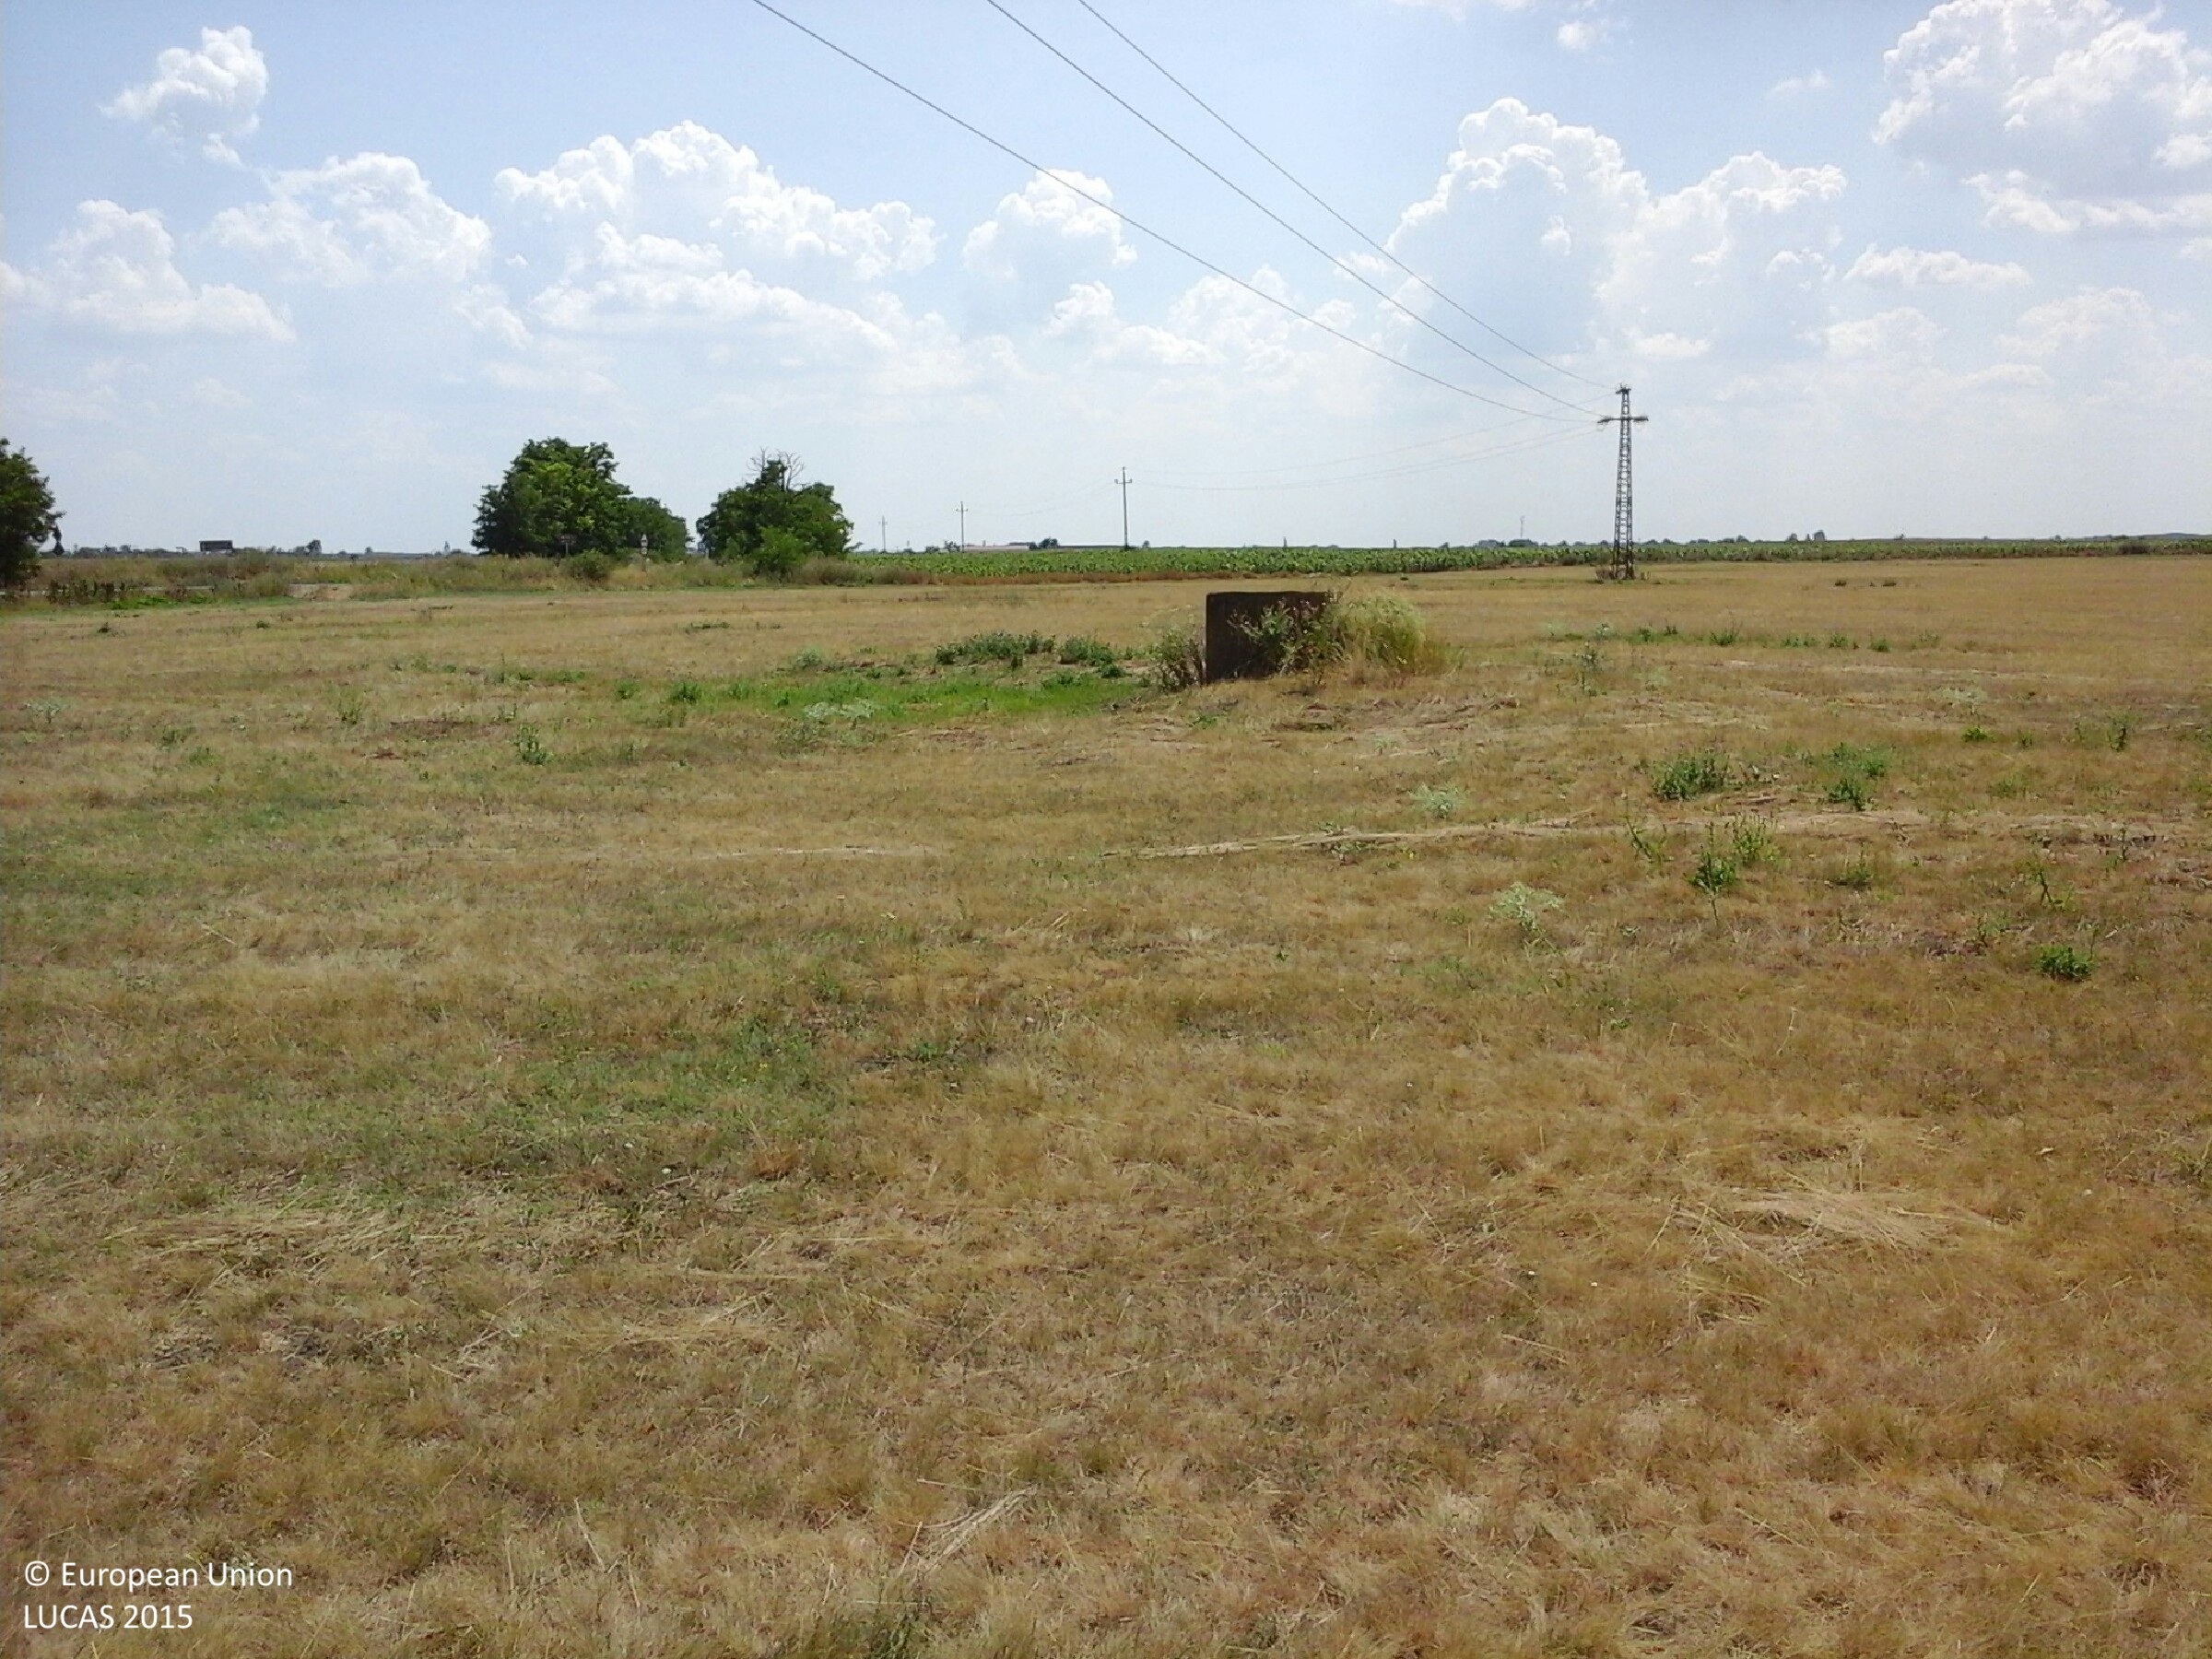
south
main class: Grassland
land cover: Grassland without tree/shrub cover
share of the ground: > 75 %
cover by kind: herbaceous plants 100 %
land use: Agriculture (excluding fallow land and kitchen gardens)
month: July
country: HU
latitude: 47.6878
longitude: 20.6516
